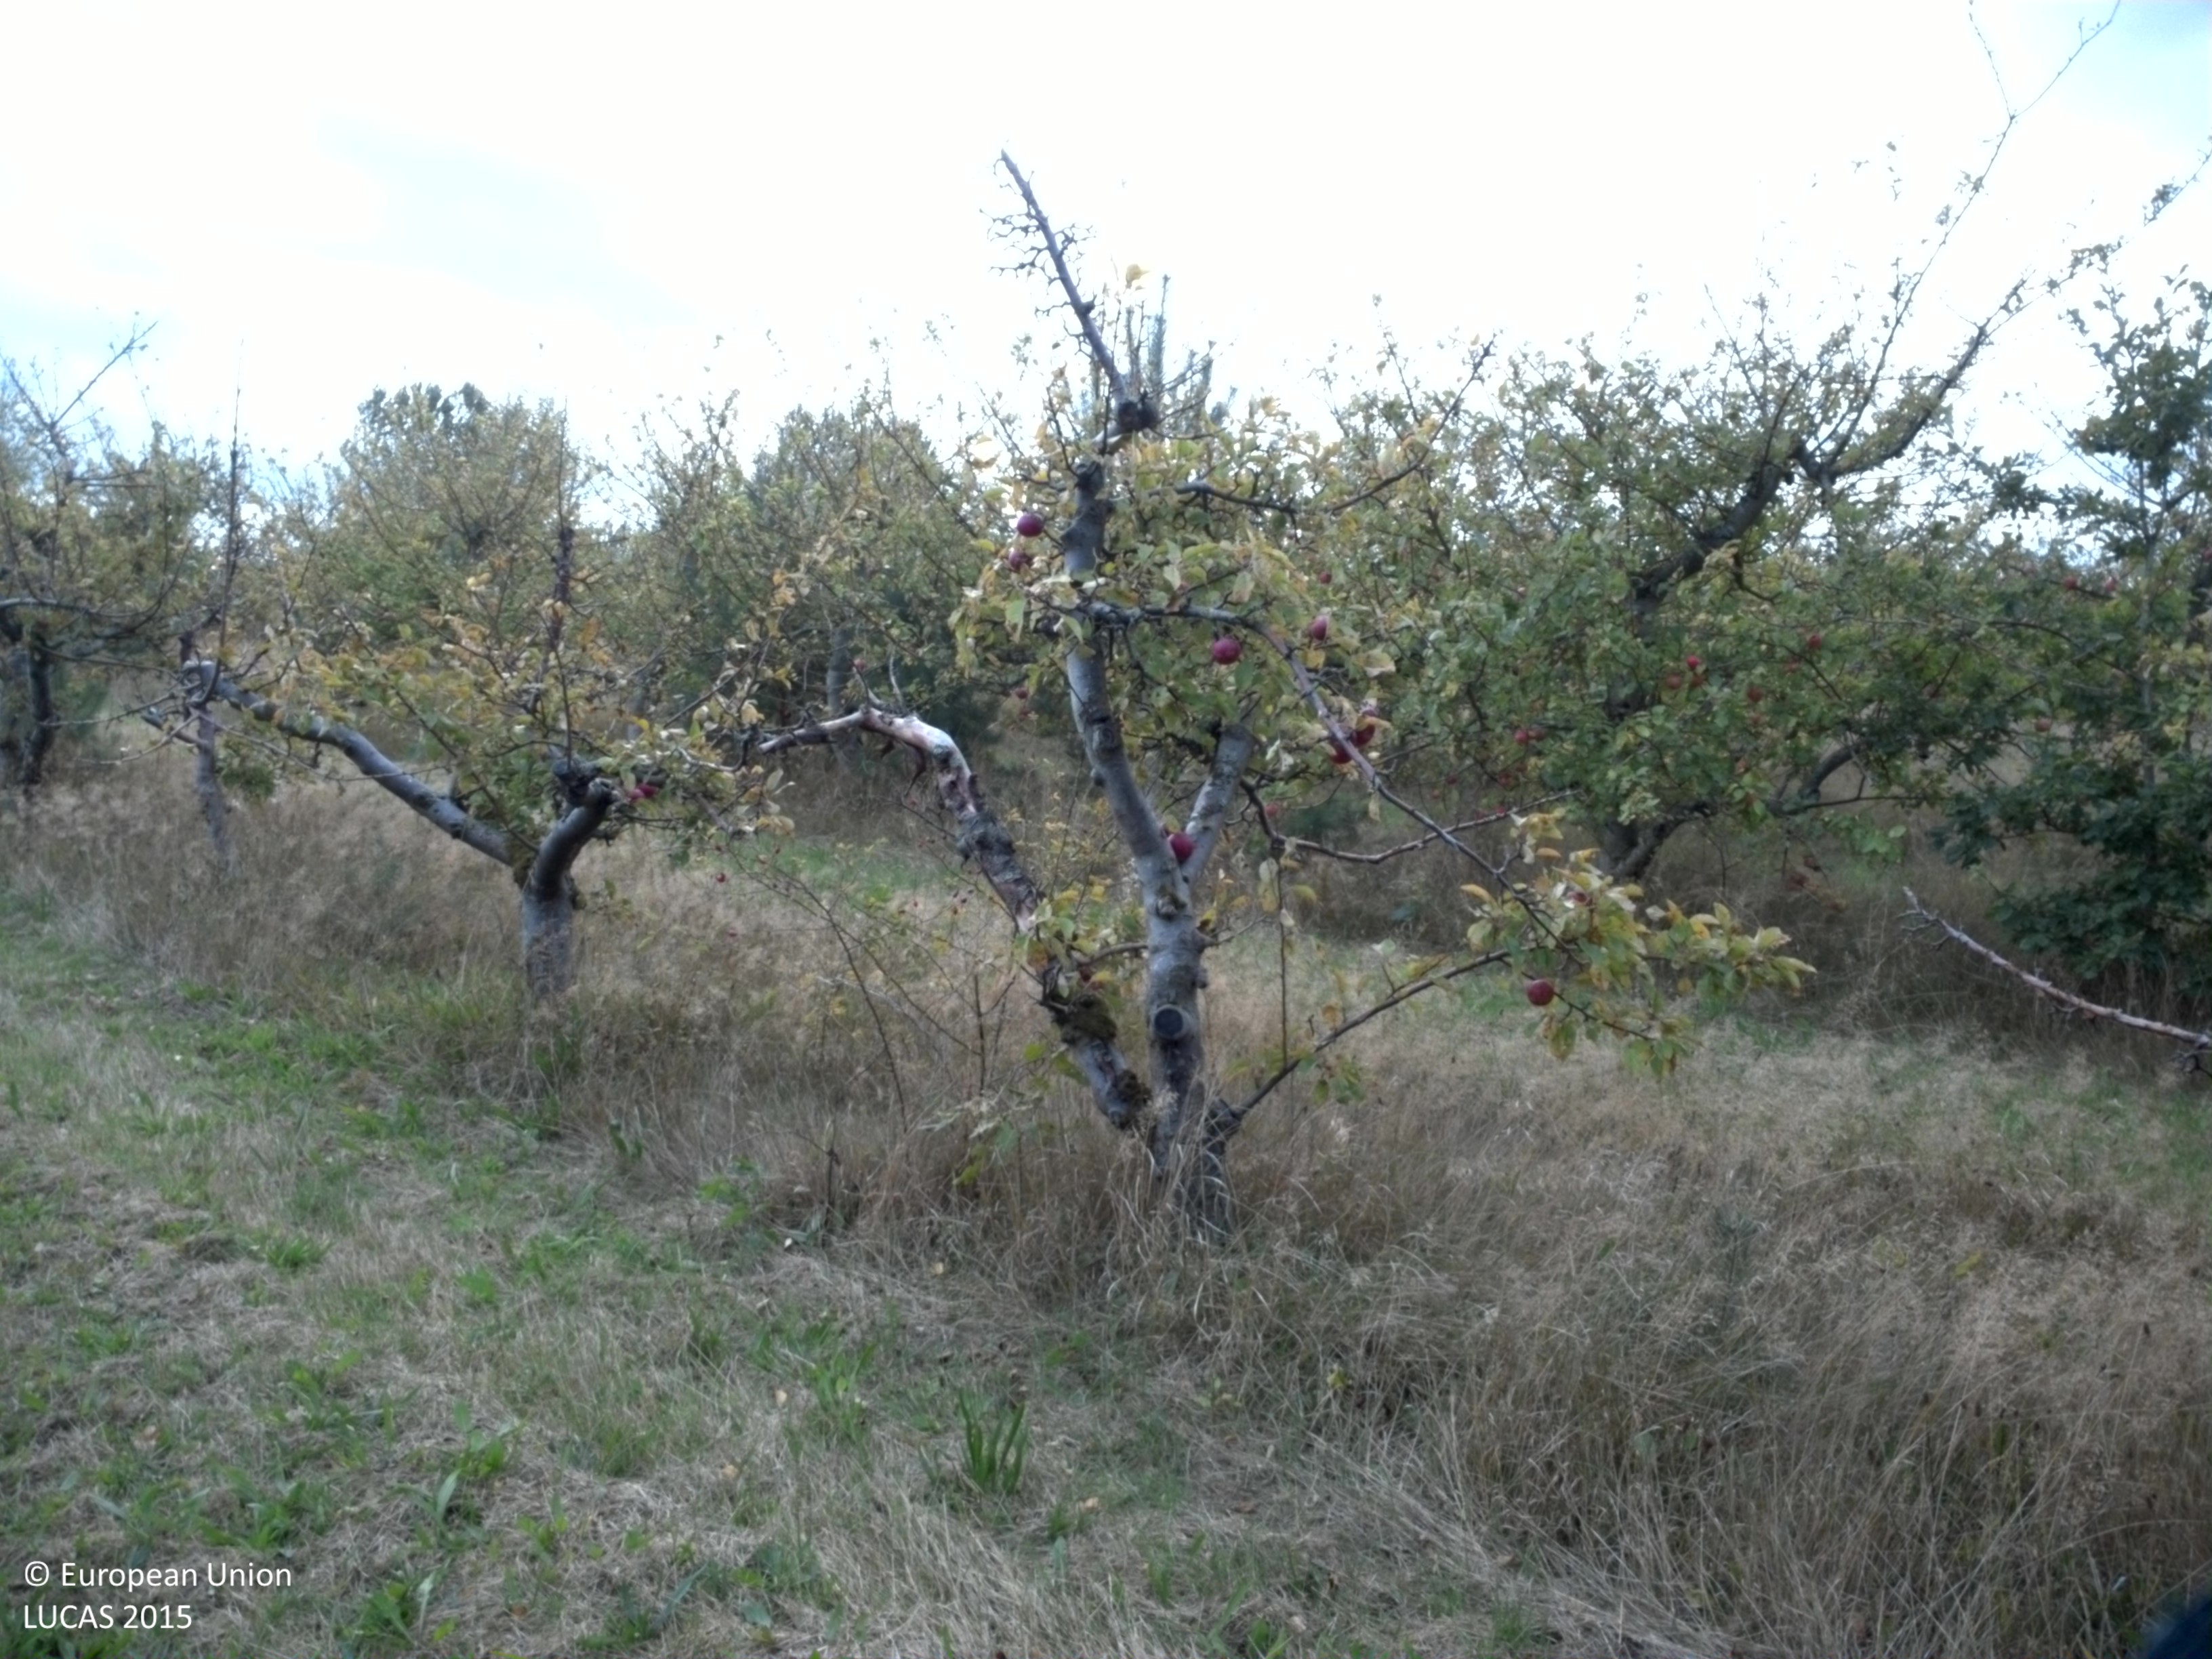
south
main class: Cropland
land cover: Apple fruit
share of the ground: 25 - 50 %
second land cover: Grassland without tree/shrub cover
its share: 50 - 75 %
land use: Agriculture (excluding fallow land and kitchen gardens)
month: October
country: SE
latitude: 55.5937
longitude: 14.2990
